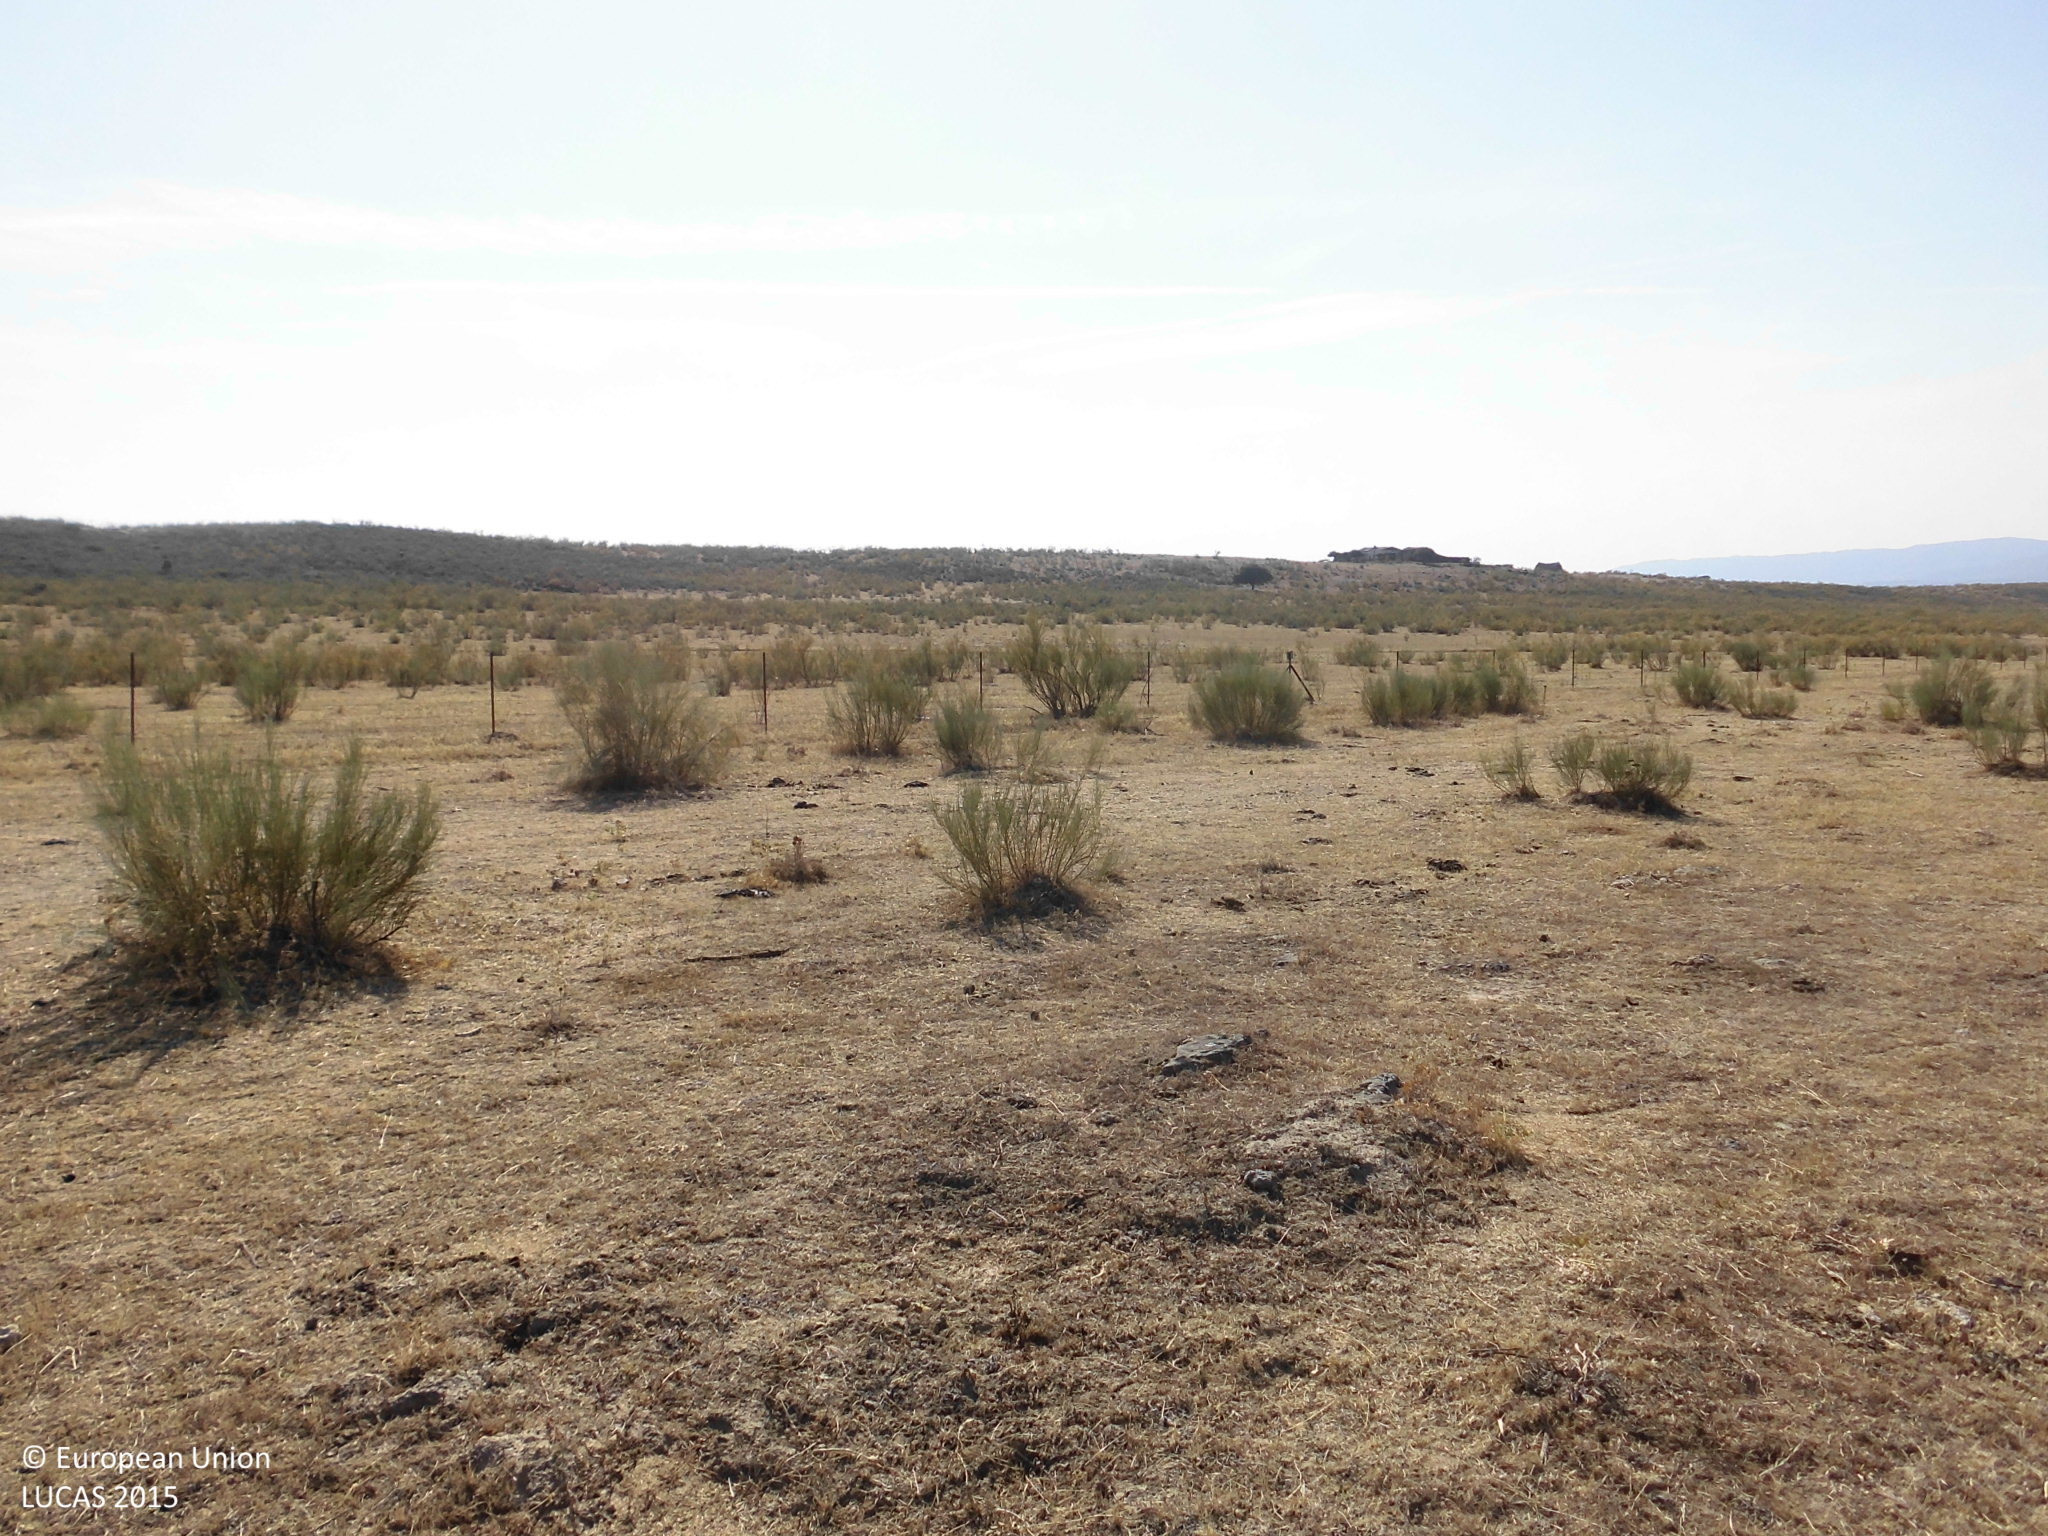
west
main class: Grassland
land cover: Grassland without tree/shrub cover
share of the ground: > 75 %
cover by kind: herbaceous plants 100 %
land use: Agriculture (excluding fallow land and kitchen gardens)
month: July
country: ES
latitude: 40.0403
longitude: -6.5959
